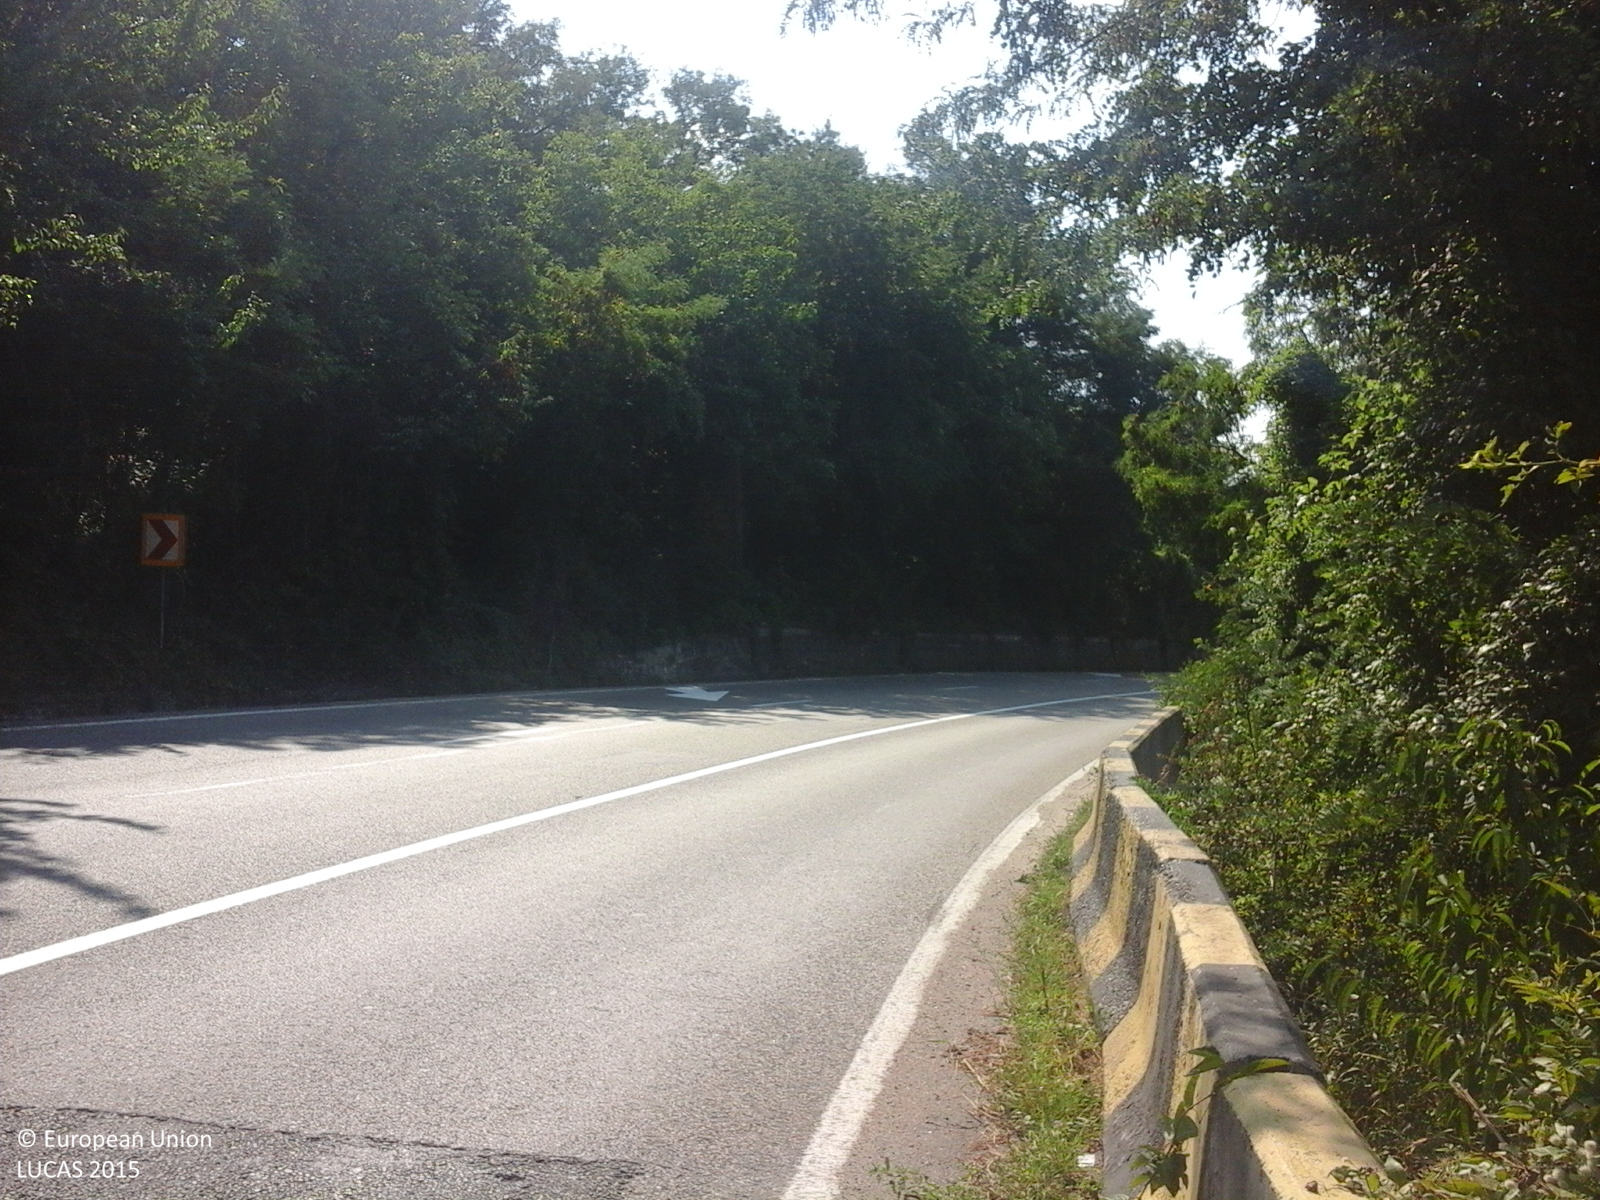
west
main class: Woodland
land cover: Broadleaved woodland
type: broadleaved evergreen forest
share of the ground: > 75 %
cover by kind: broadleaved forest trees 100 %
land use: Forestry
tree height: > 5 m
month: July
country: RO
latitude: 45.0512
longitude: 24.4610
